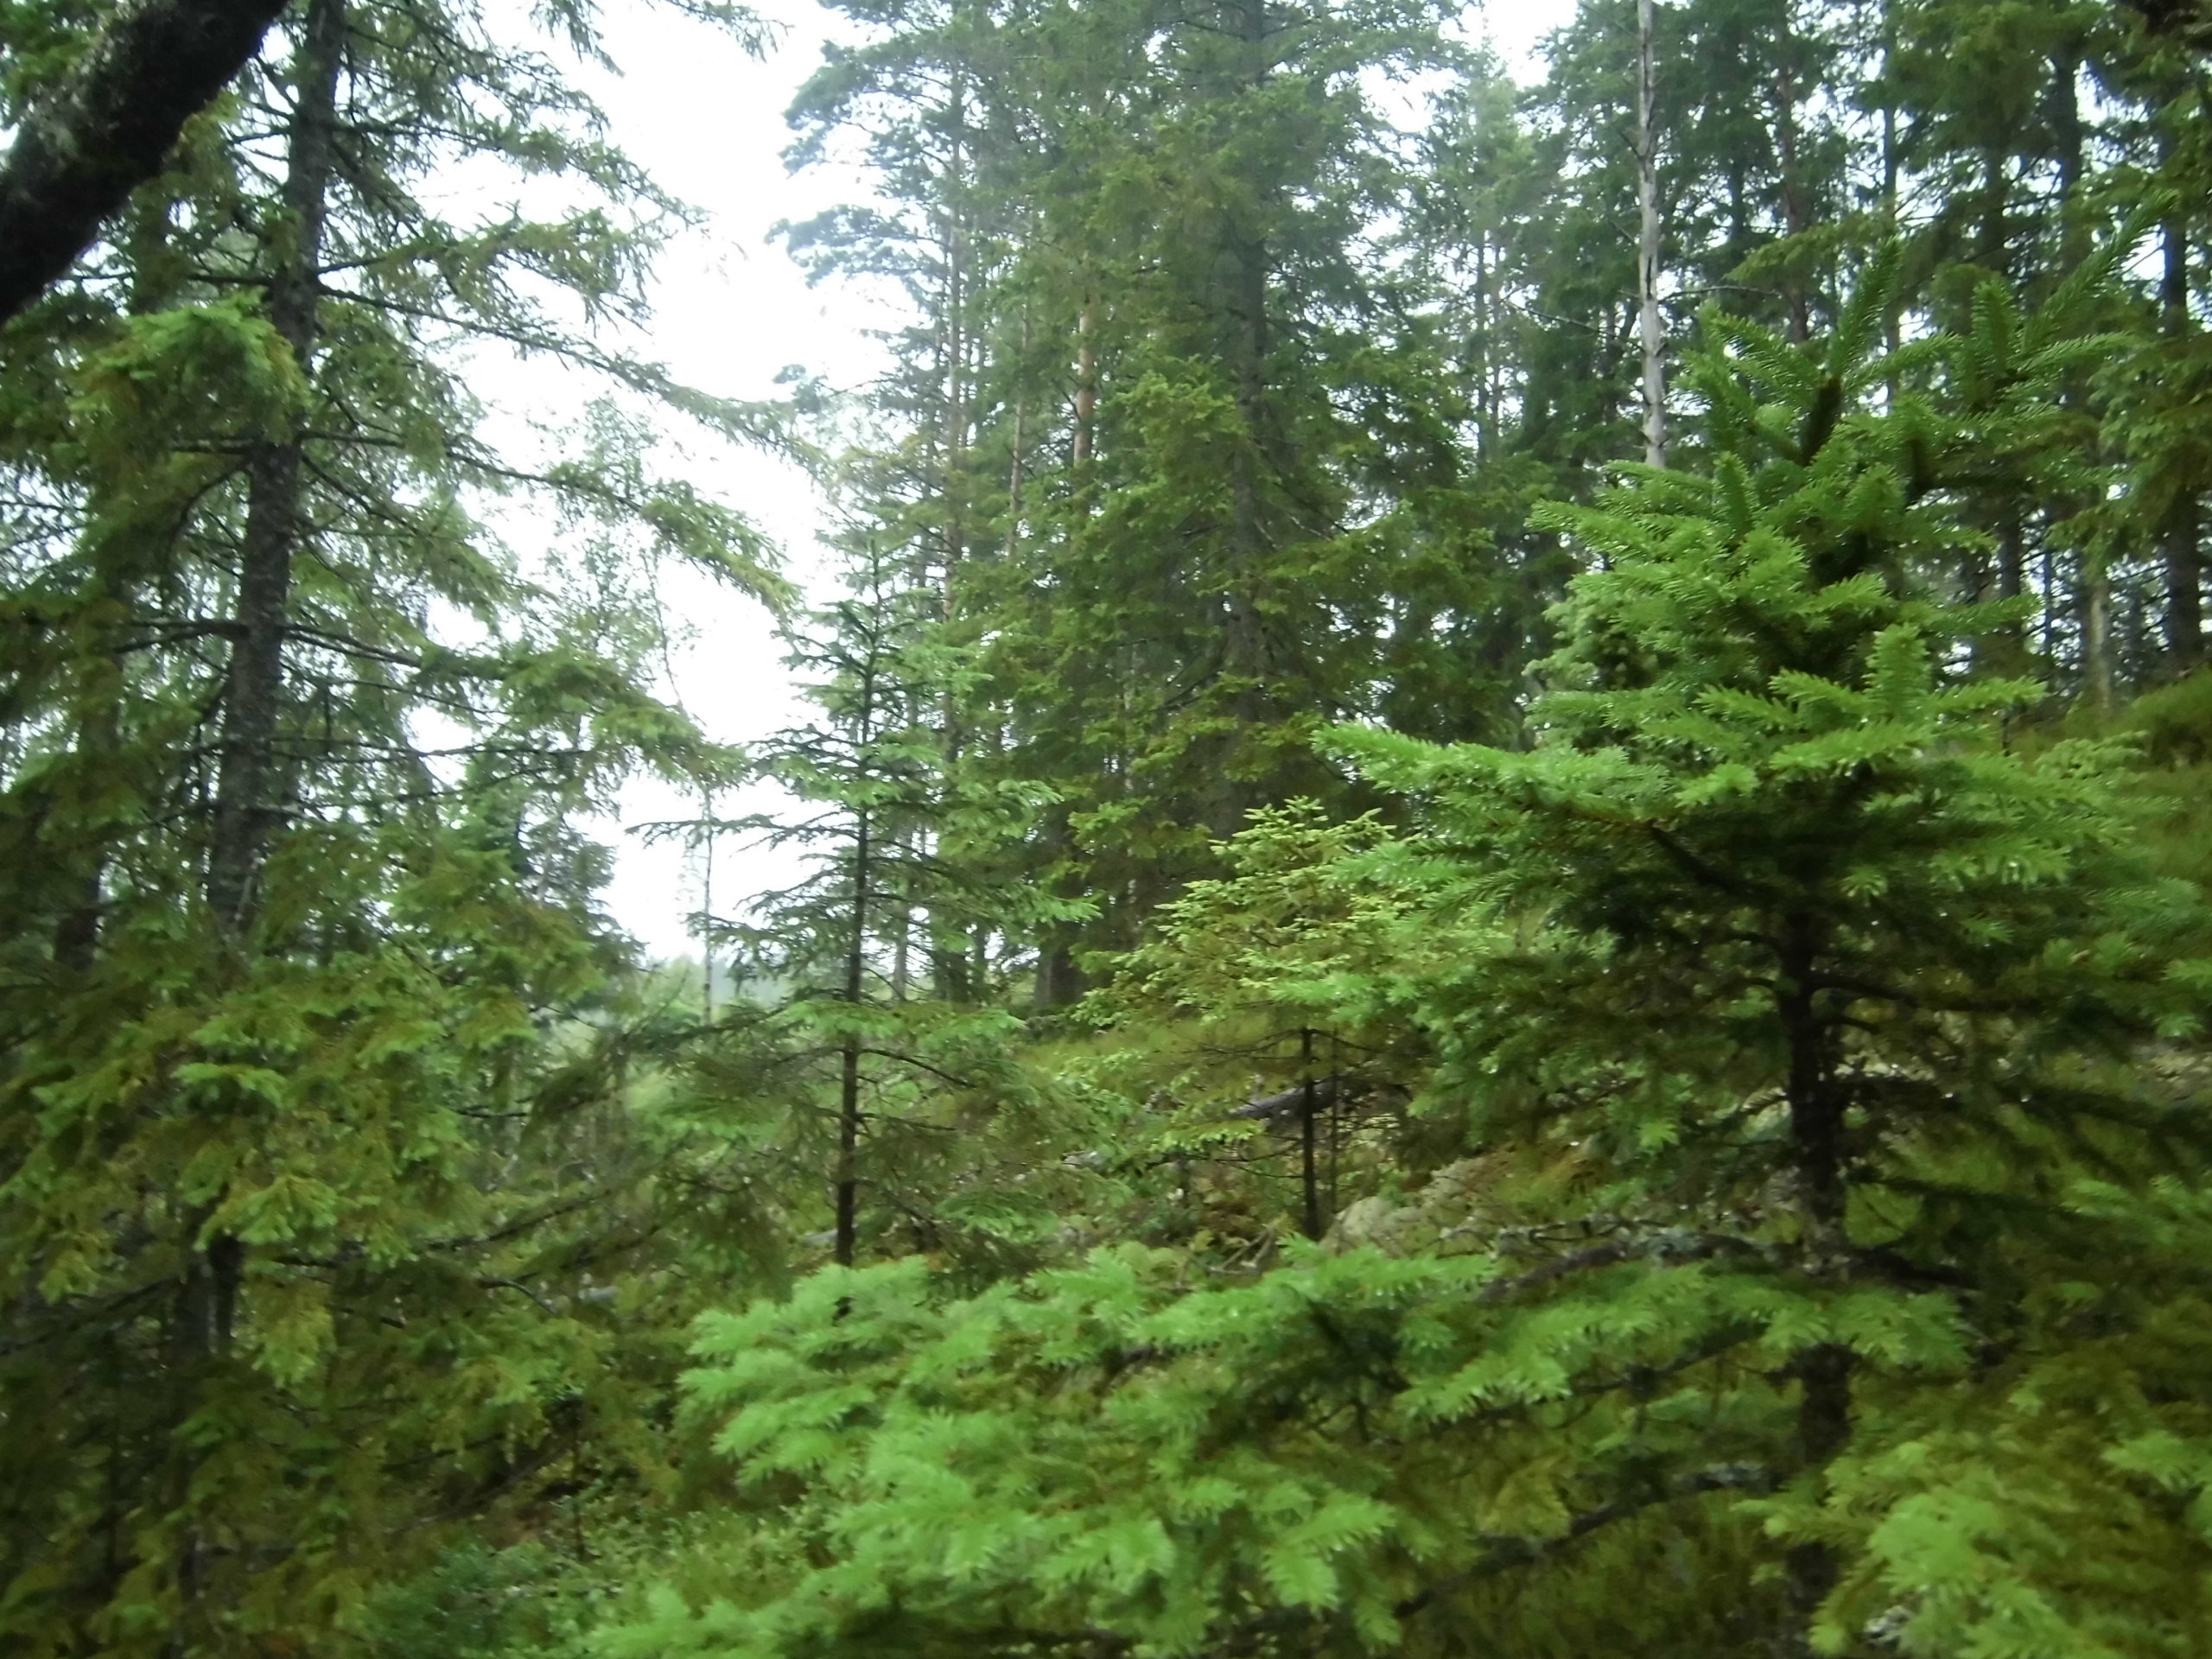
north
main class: Woodland
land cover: Spruce dominated coniferous woodland
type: boreal forest
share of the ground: 50 - 75 %
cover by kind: coniferous forest trees 45 %, shrubs 25 %, lichens and mosses 15 %, herbaceous plants 10 %, broadleaved forest trees 5 %
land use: Forestry
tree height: > 5 m
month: July
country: SE
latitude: 57.2211
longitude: 15.1142
